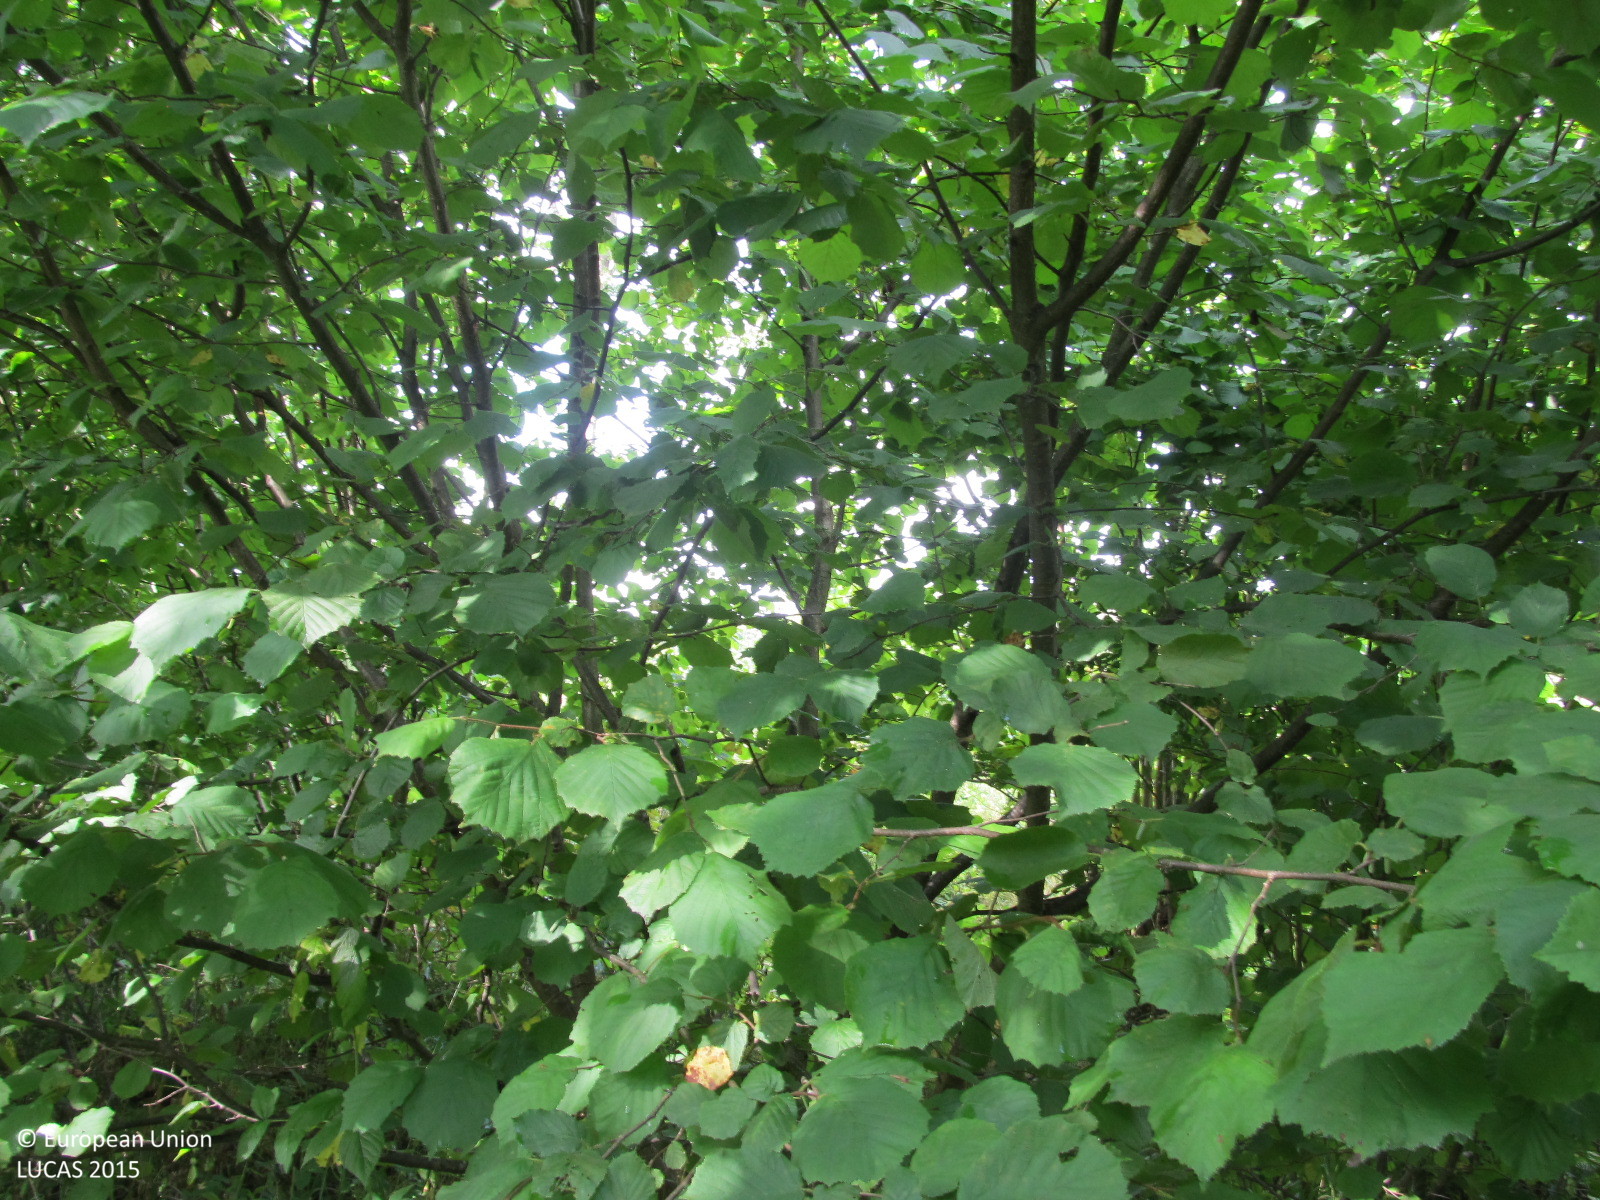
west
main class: Woodland
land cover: Broadleaved woodland
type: non-riverine alder, birch or aspen forest
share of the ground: > 75 %
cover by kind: broadleaved forest trees 80 %, shrubs 10 %, herbaceous plants 10 %
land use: Forestry
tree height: < 5 m
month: September
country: LT
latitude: 55.6223
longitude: 22.5591
